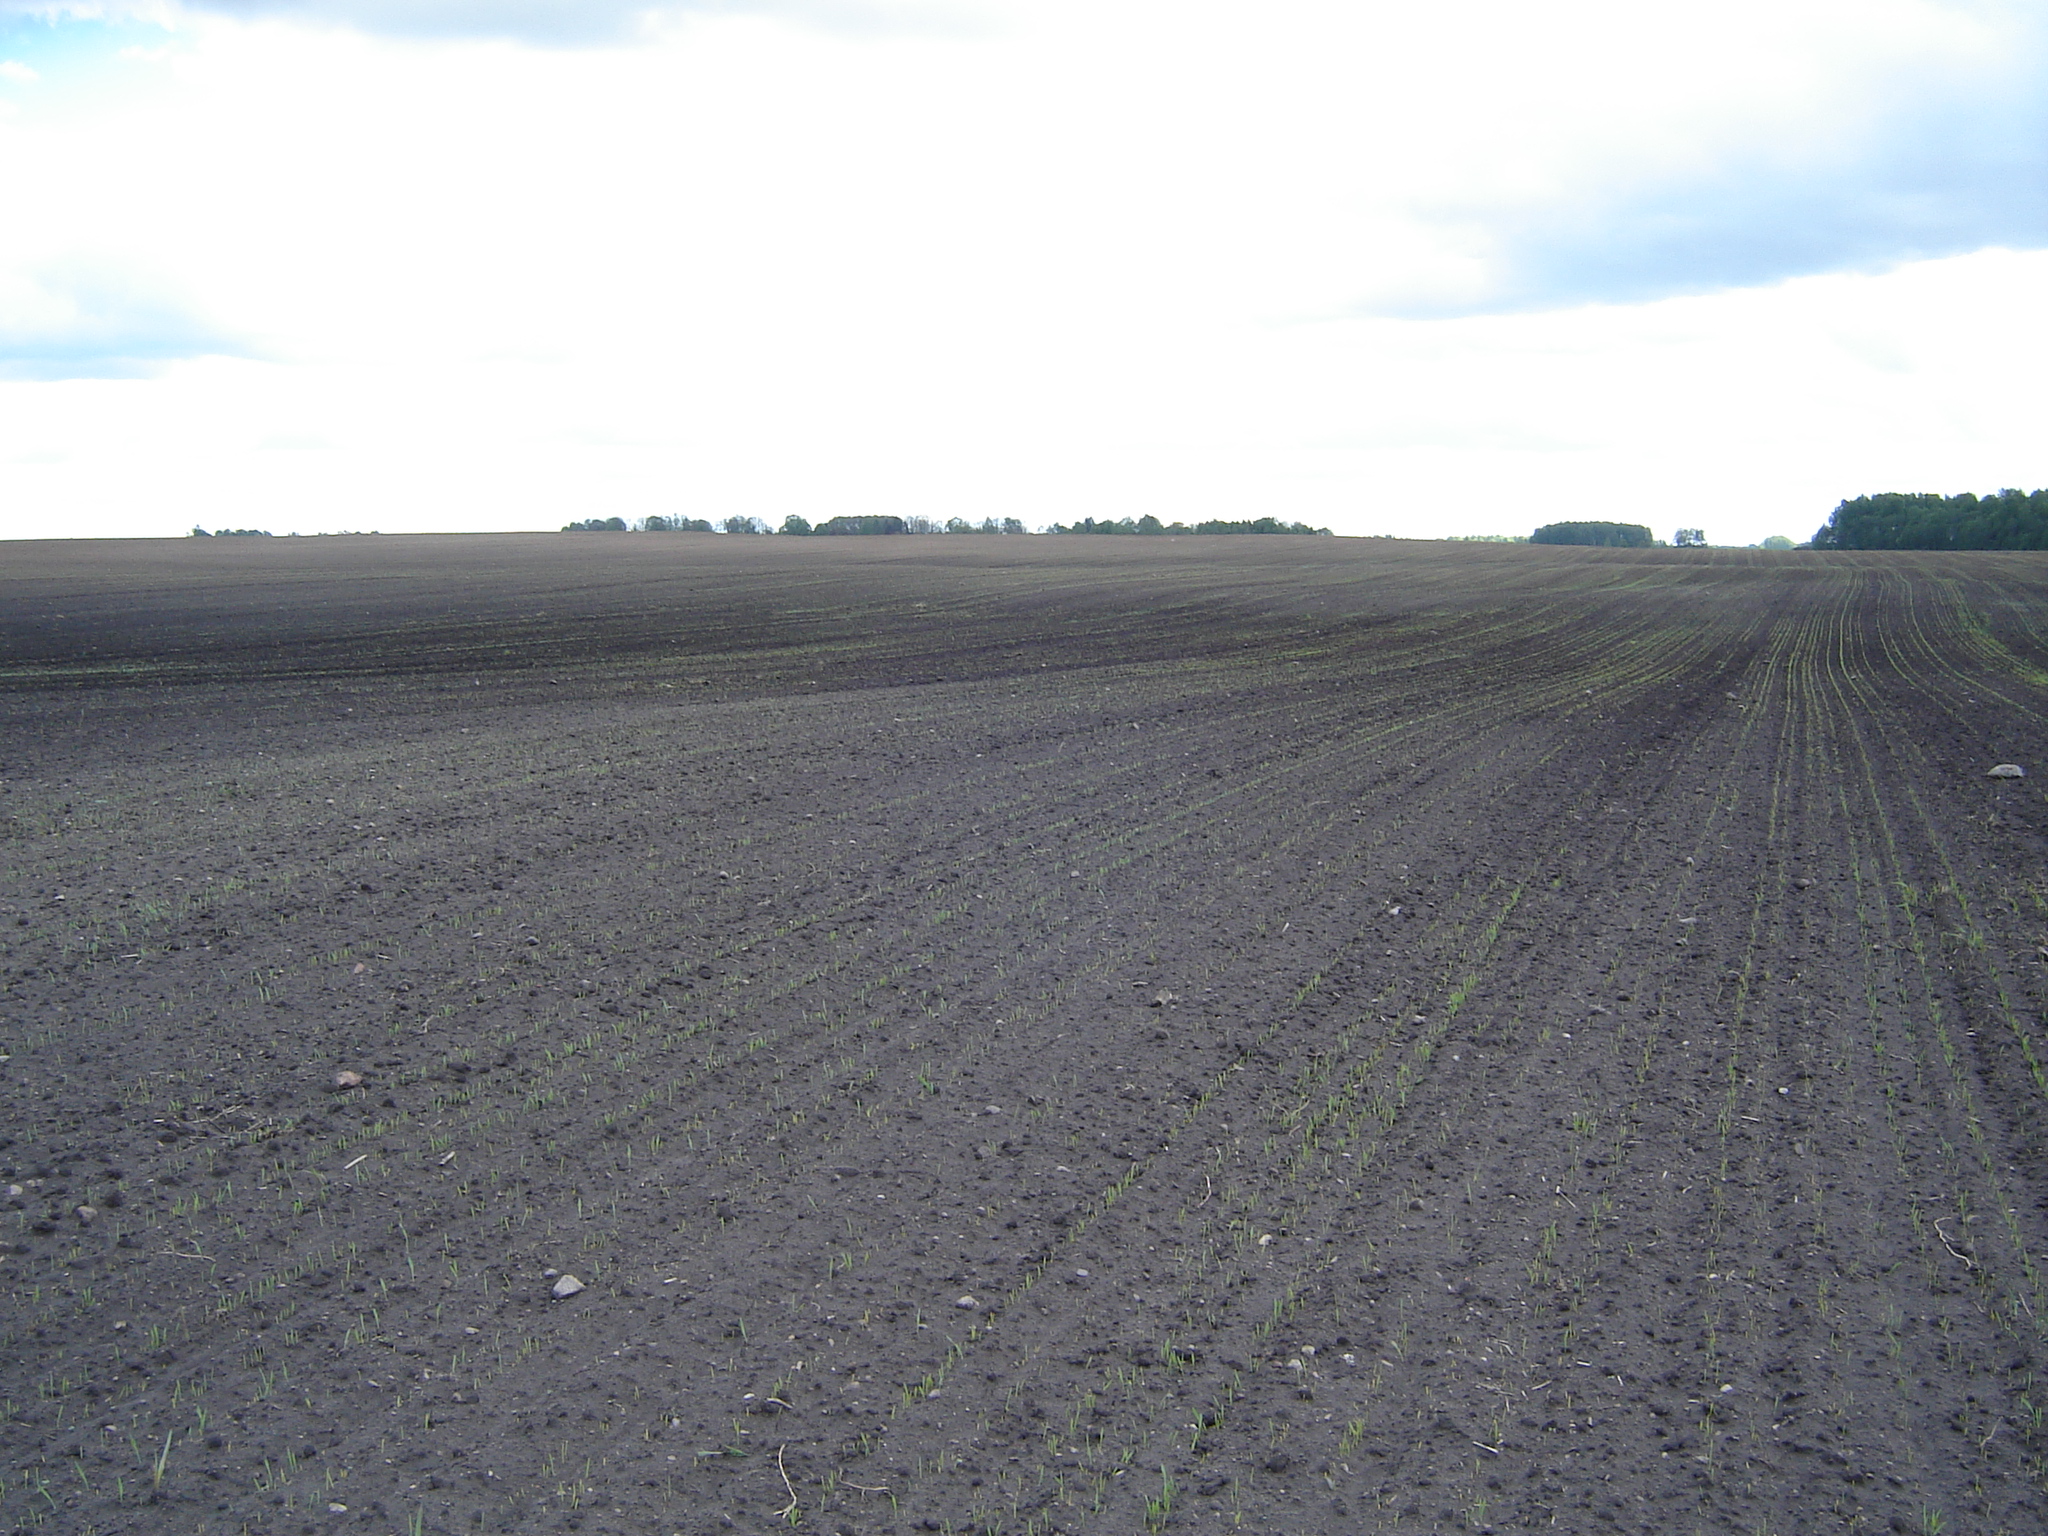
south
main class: Cropland
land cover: Barley
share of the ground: < 10 %
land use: Agriculture (excluding fallow land and kitchen gardens)
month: May
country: LT
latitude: 55.9897
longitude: 25.1995
